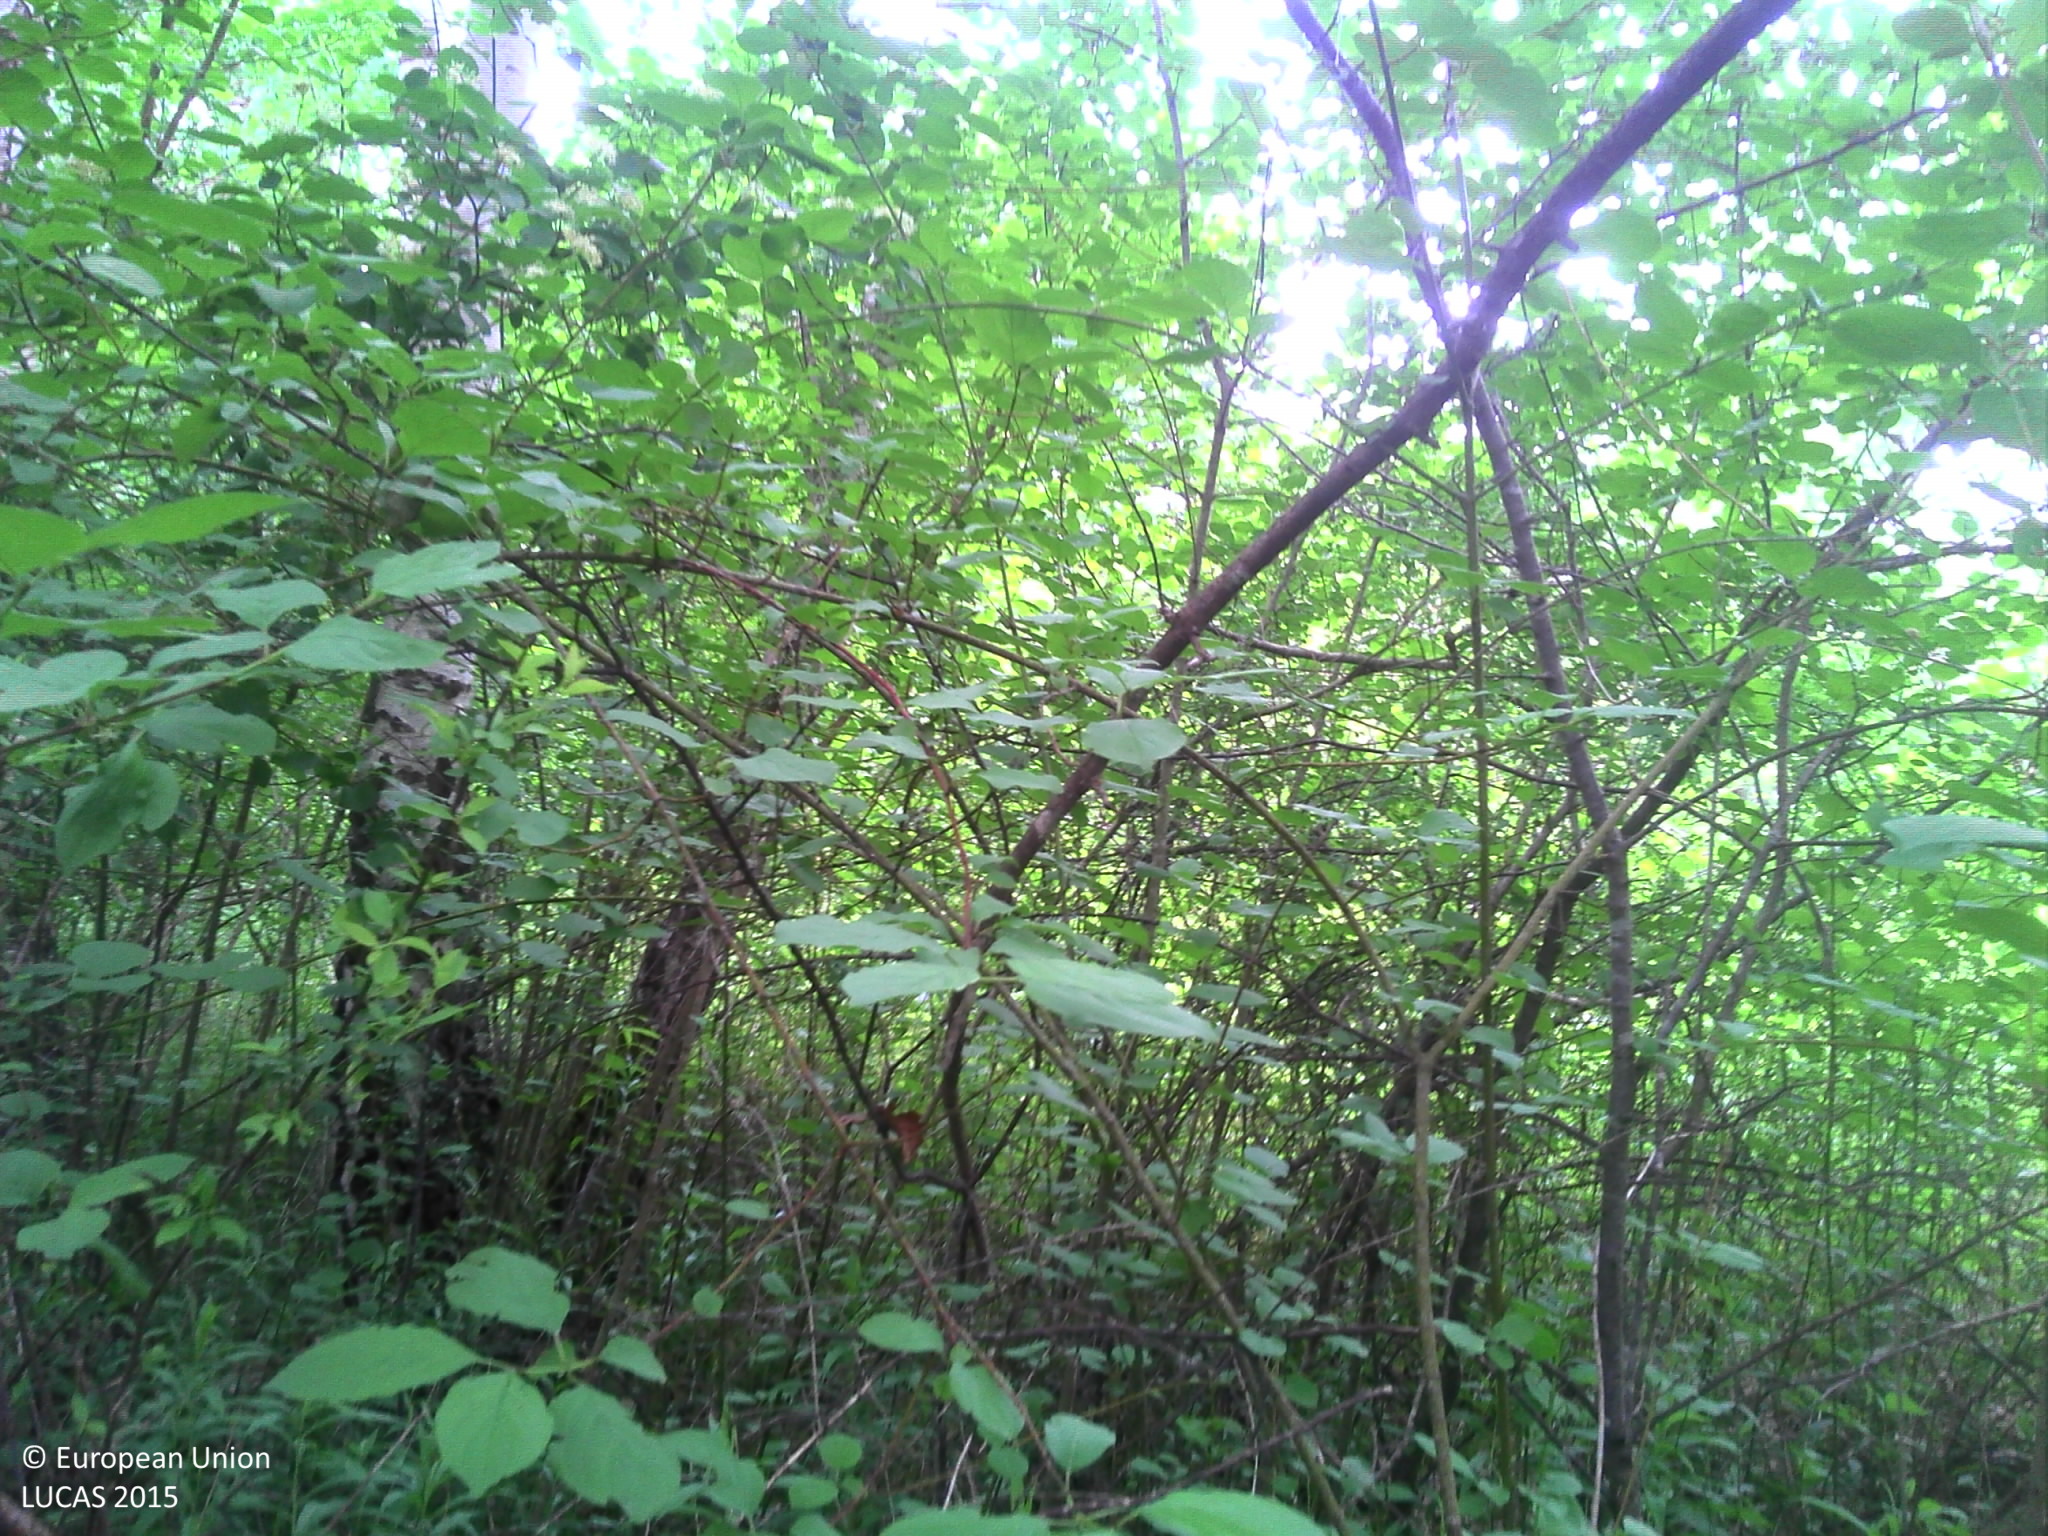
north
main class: Woodland
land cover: Broadleaved woodland
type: mesophytic deciduous forest
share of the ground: > 75 %
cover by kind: broadleaved forest trees 80 %, herbaceous plants 20 %
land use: Forestry
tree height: > 5 m
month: June
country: FR
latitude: 47.9089
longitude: 7.5797
